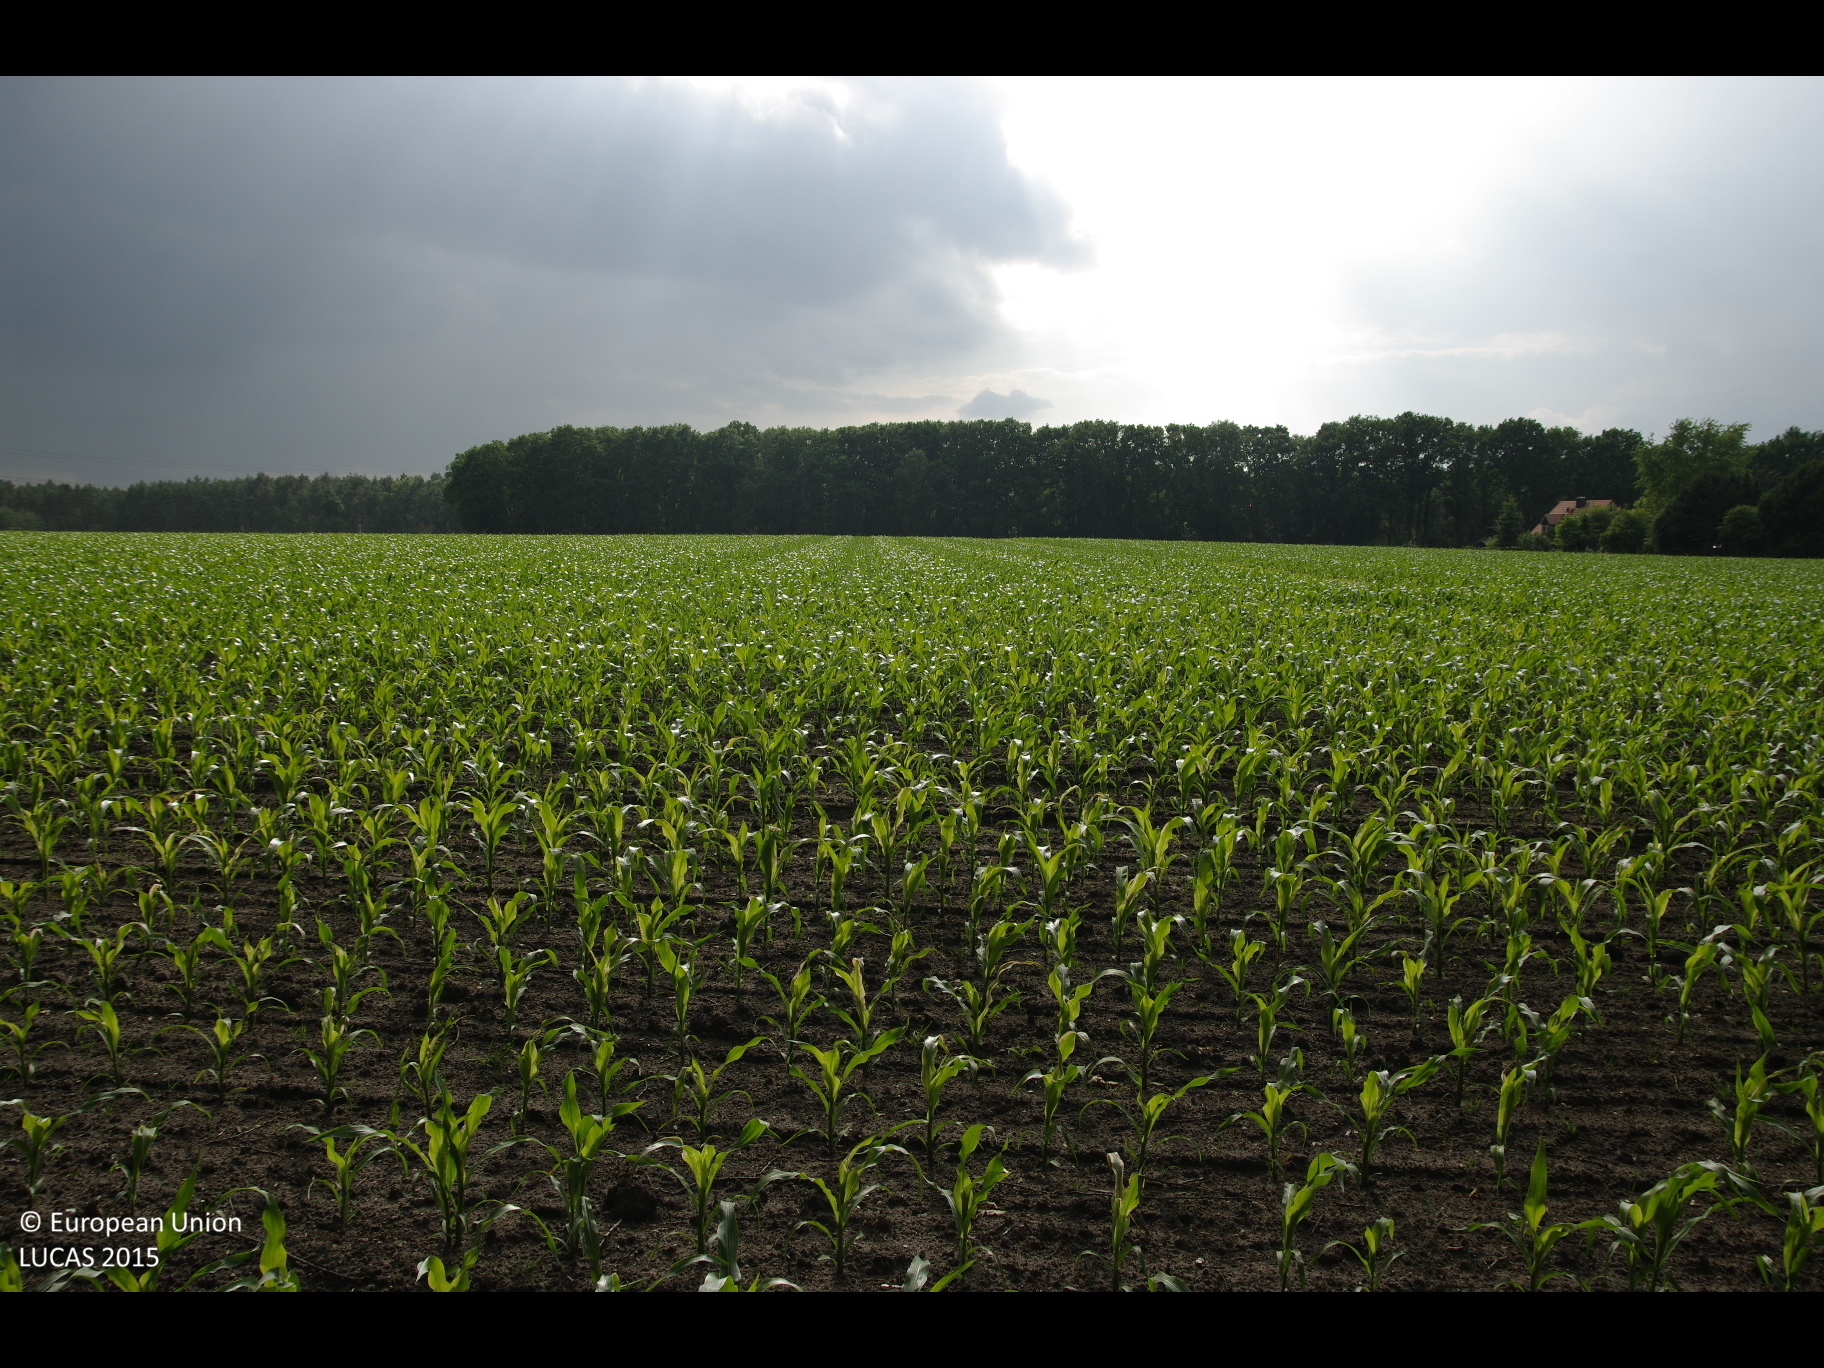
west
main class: Cropland
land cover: Maize
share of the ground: 25 - 50 %
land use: Agriculture (excluding fallow land and kitchen gardens)
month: June
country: DE
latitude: 53.2757
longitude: 10.3148
